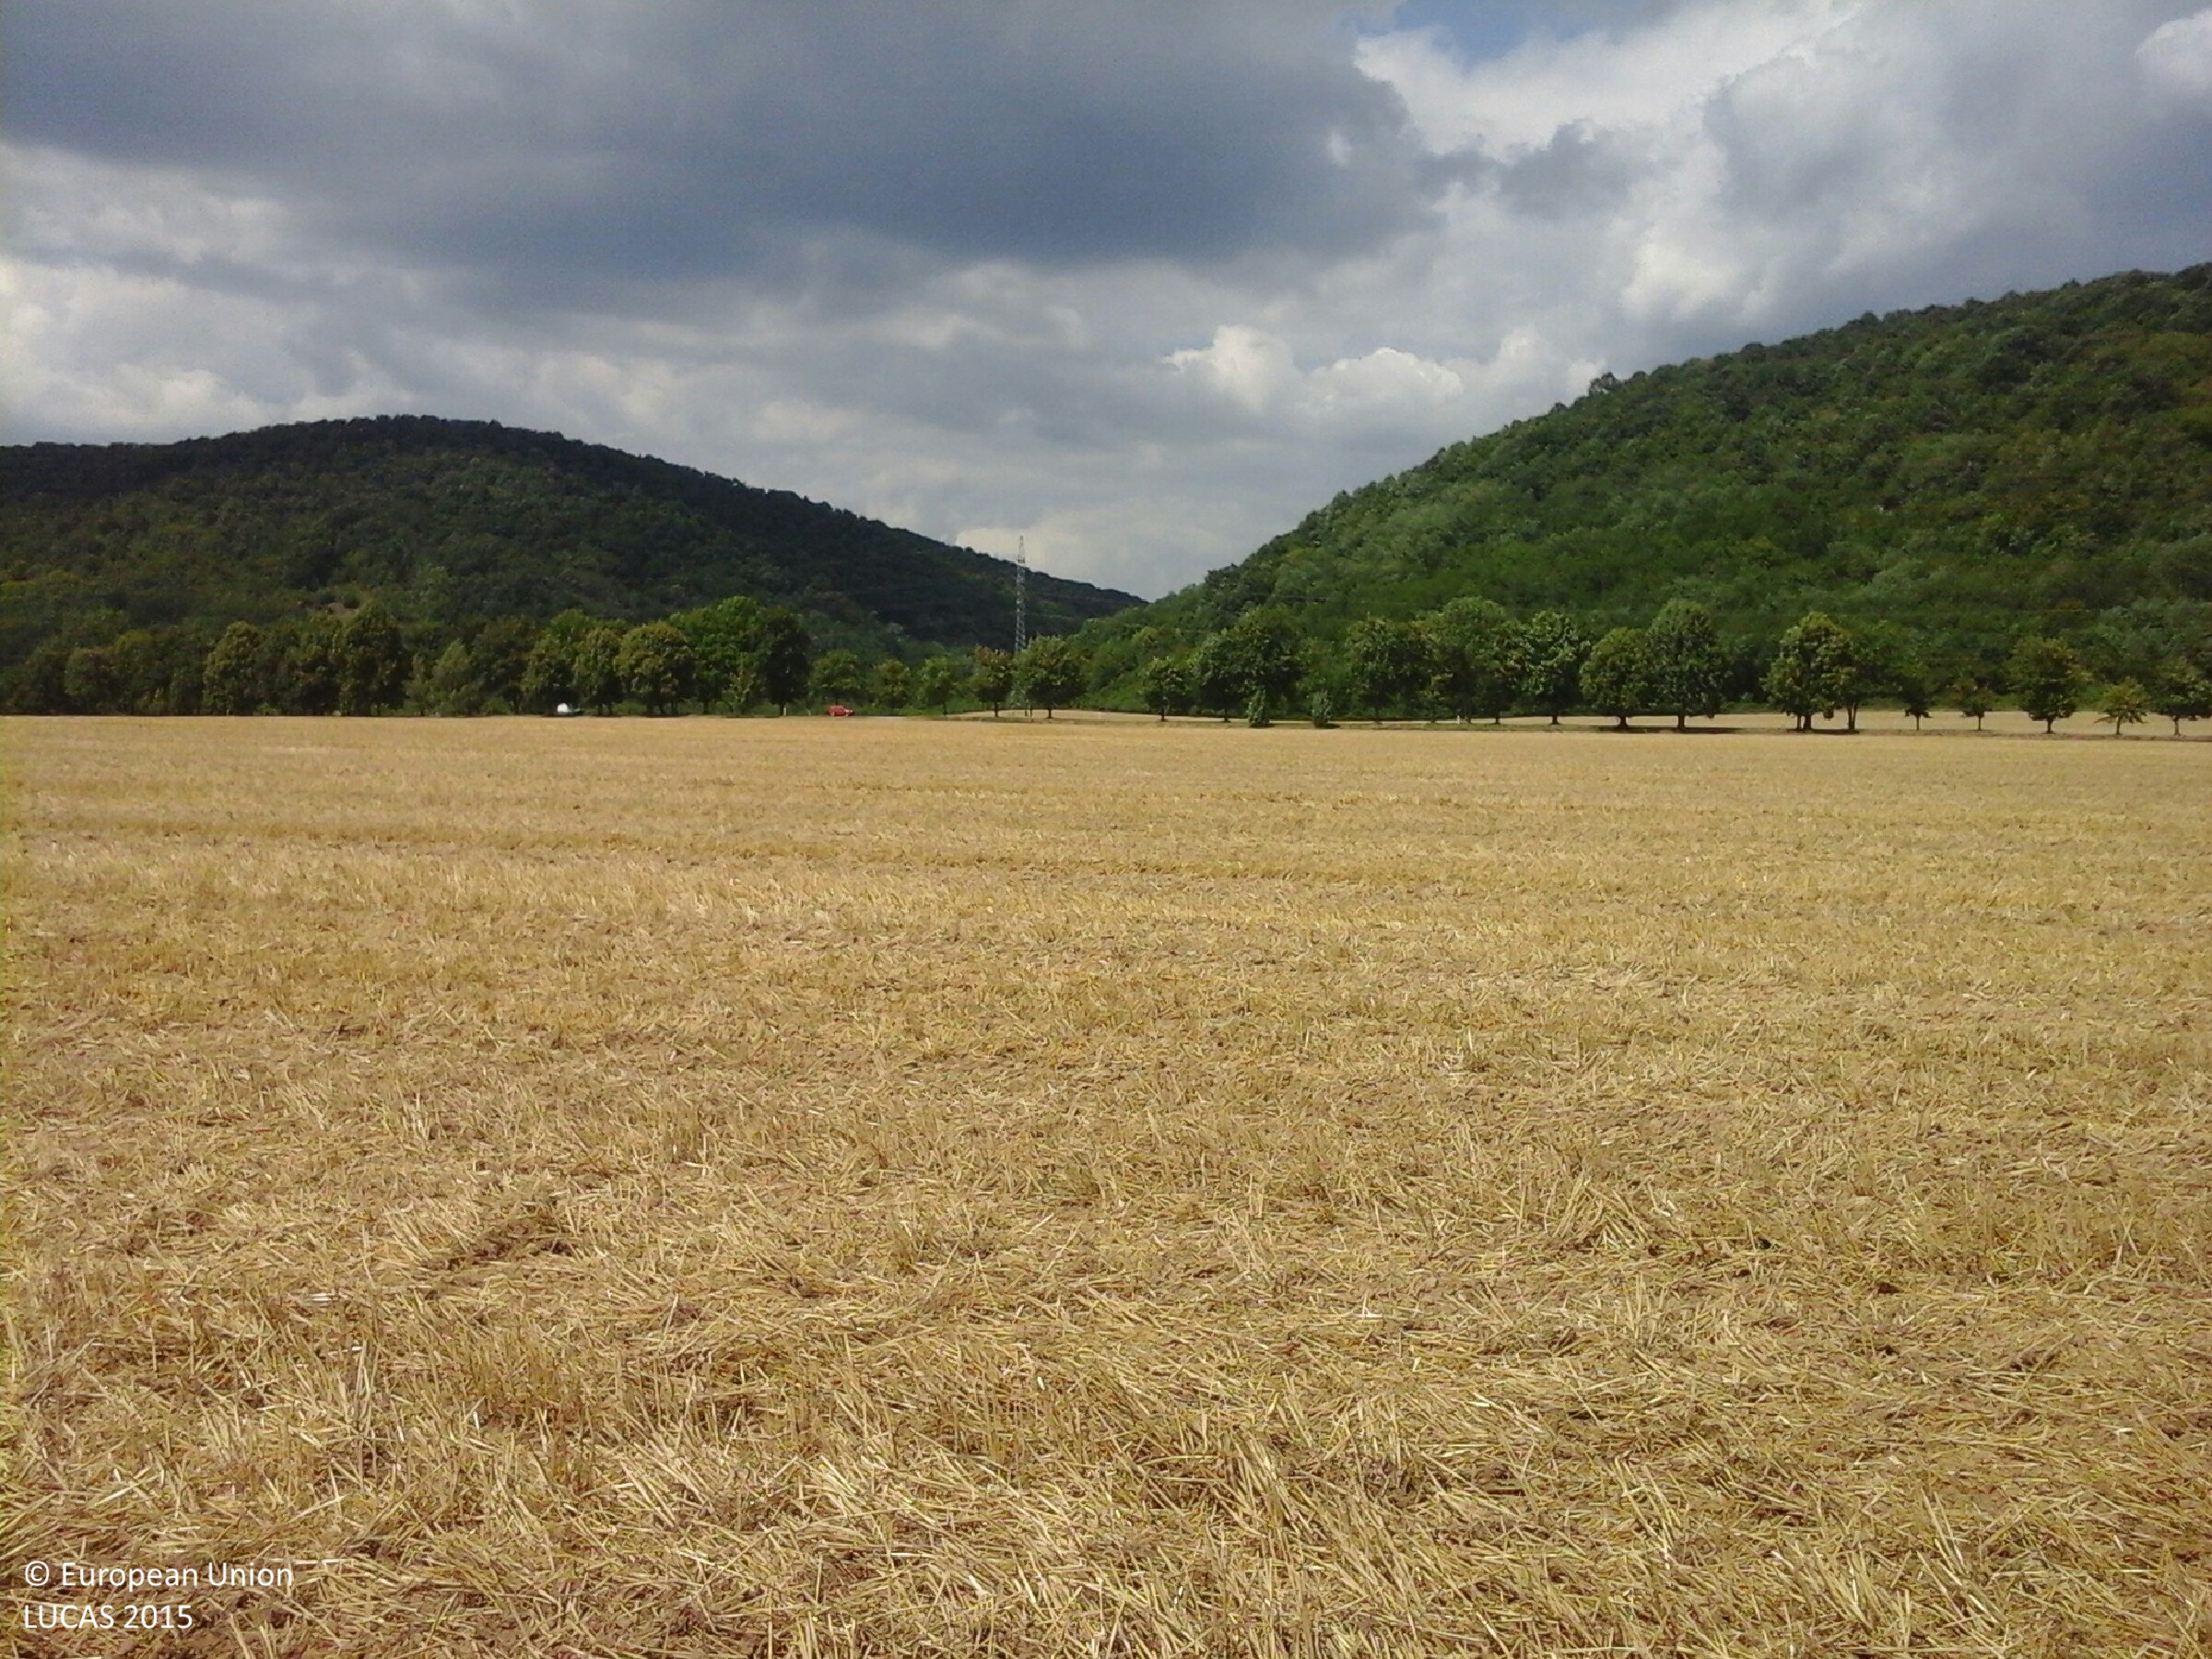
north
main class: Cropland
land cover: Common wheat
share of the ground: 25 - 50 %
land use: Agriculture (excluding fallow land and kitchen gardens)
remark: Harvested field
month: July
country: HU
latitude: 48.2852
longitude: 20.4785
